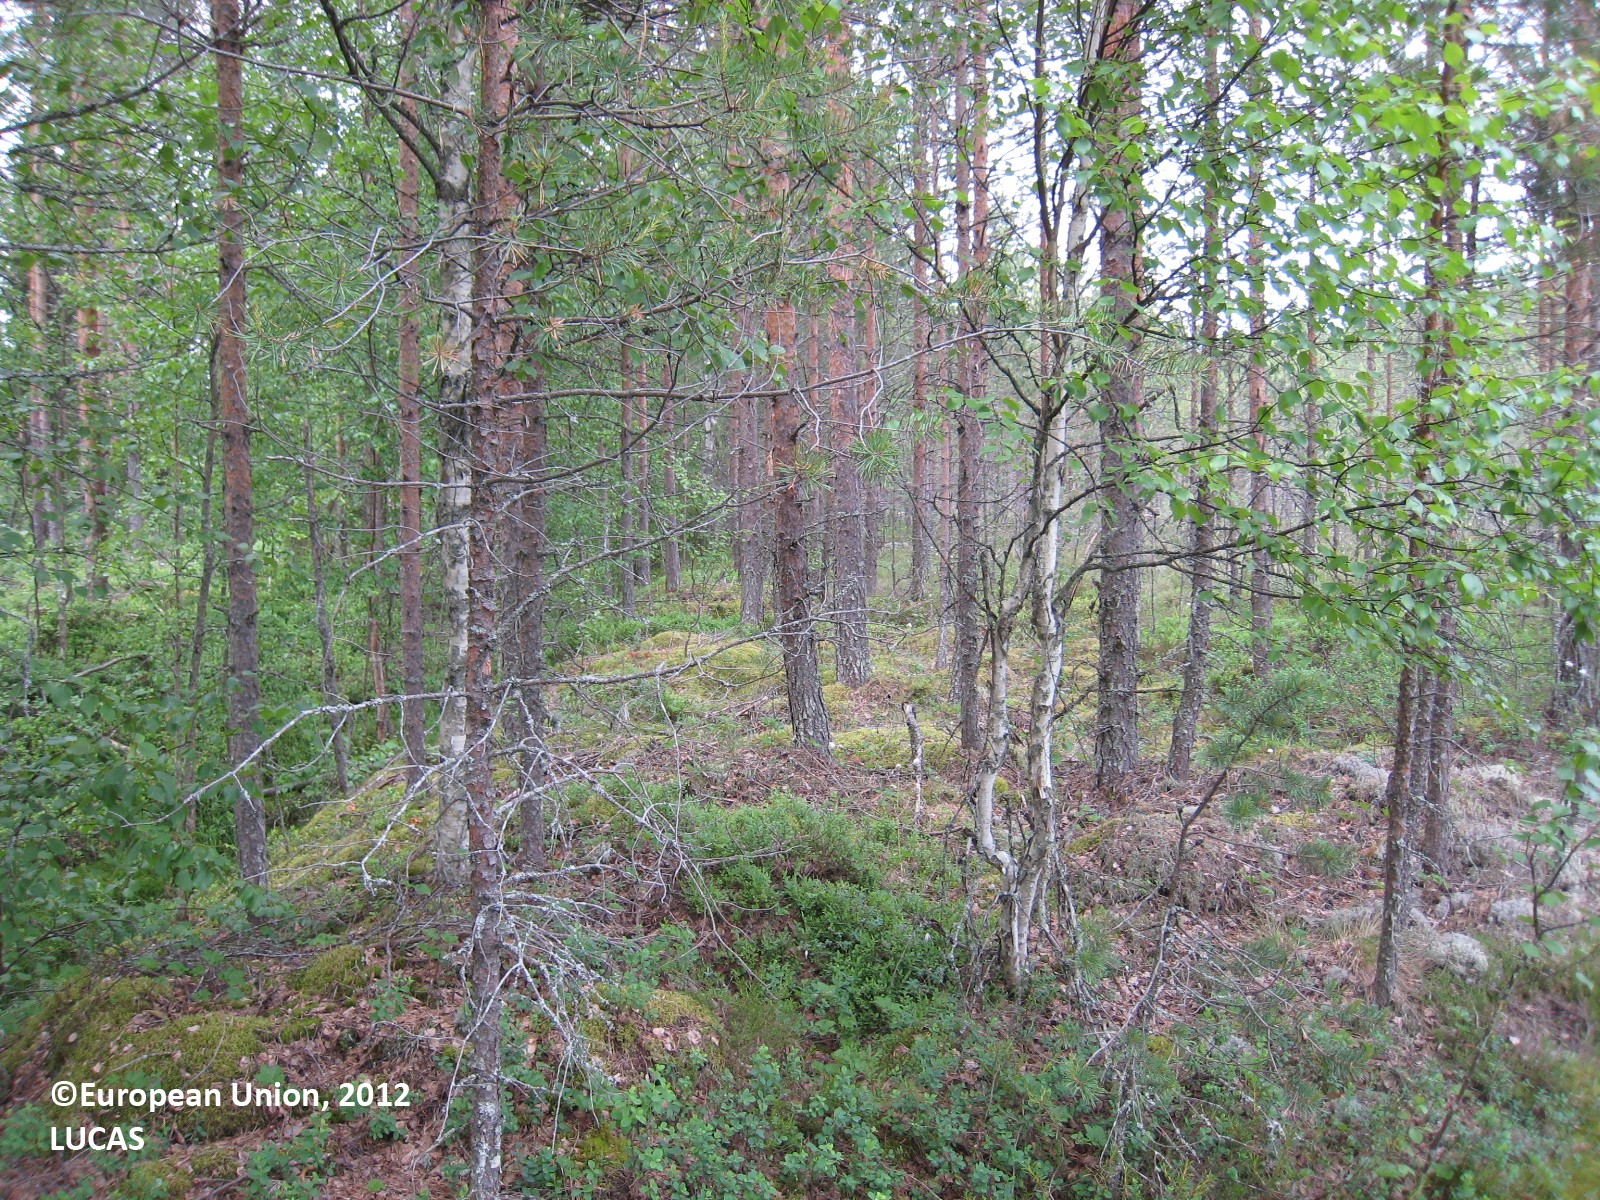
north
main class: Woodland
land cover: Pine dominated coniferous woodland
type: boreal forest
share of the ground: 50 - 75 %
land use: Forestry
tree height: > 5 m
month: June
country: FI
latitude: 61.9473
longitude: 26.2033
